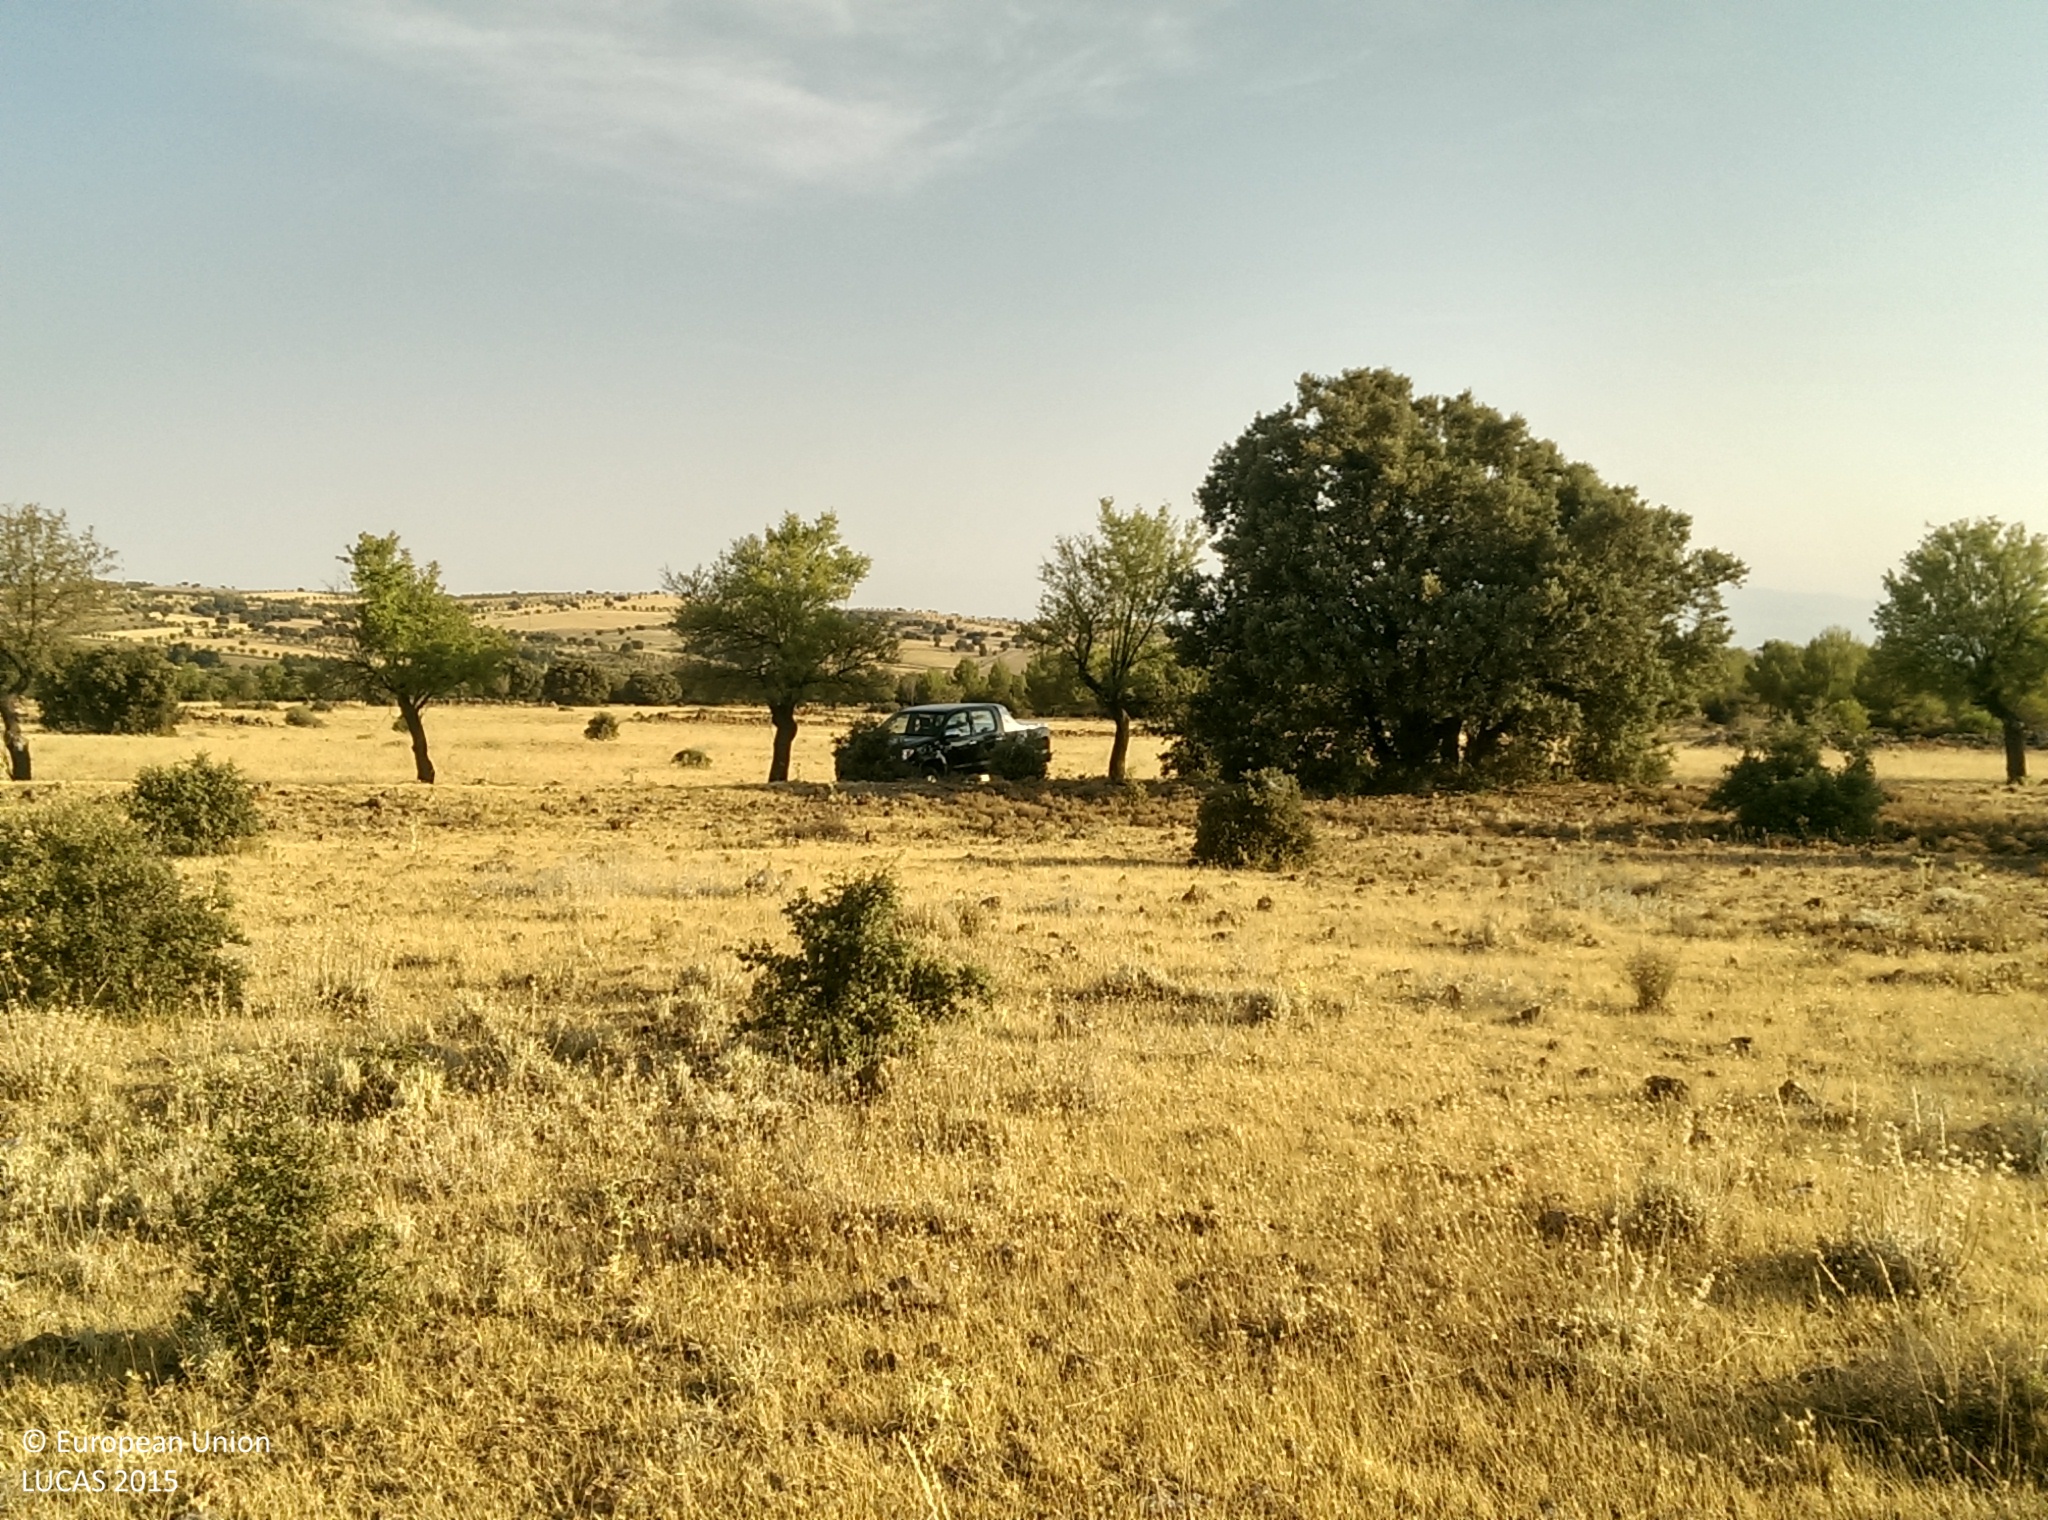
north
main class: Grassland
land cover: Grassland with sparse tree/shrub cover
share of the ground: > 75 %
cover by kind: herbaceous plants 90 %, broadleaved forest trees 5 %, shrubs 5 %
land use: Semi-natural and natural areas not in use
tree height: > 5 m
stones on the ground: > 50 %
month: July
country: ES
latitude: 37.3910
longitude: -2.9424
